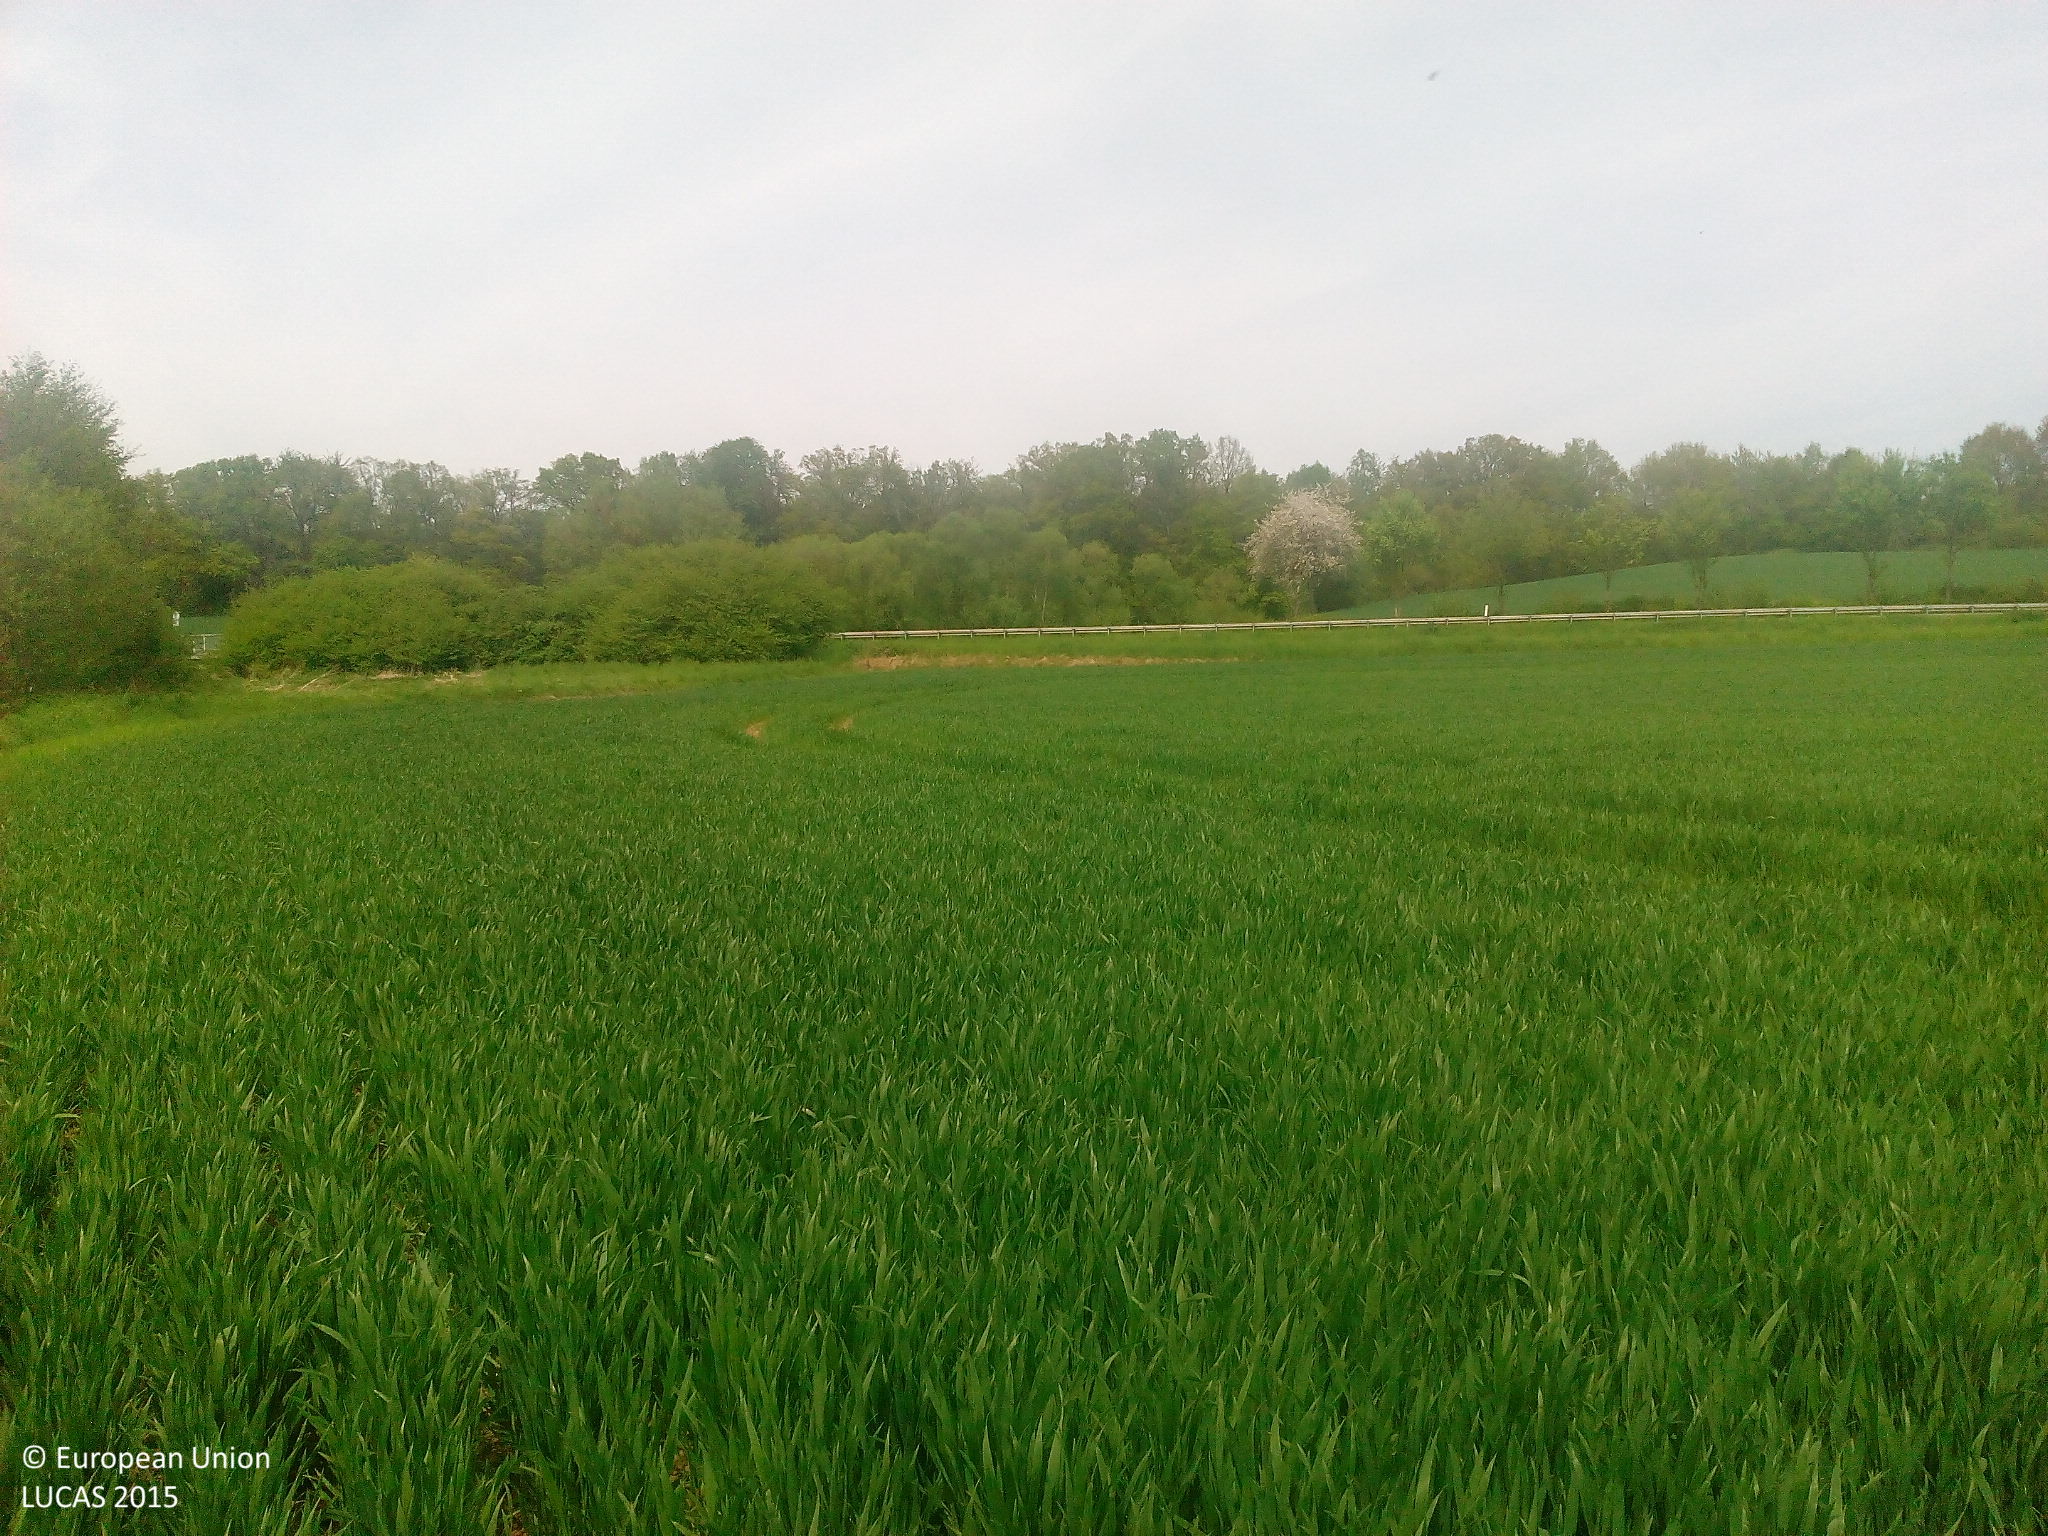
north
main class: Cropland
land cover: Common wheat
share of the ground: > 75 %
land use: Agriculture (excluding fallow land and kitchen gardens)
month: May
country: DE
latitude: 51.1371
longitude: 9.9571
